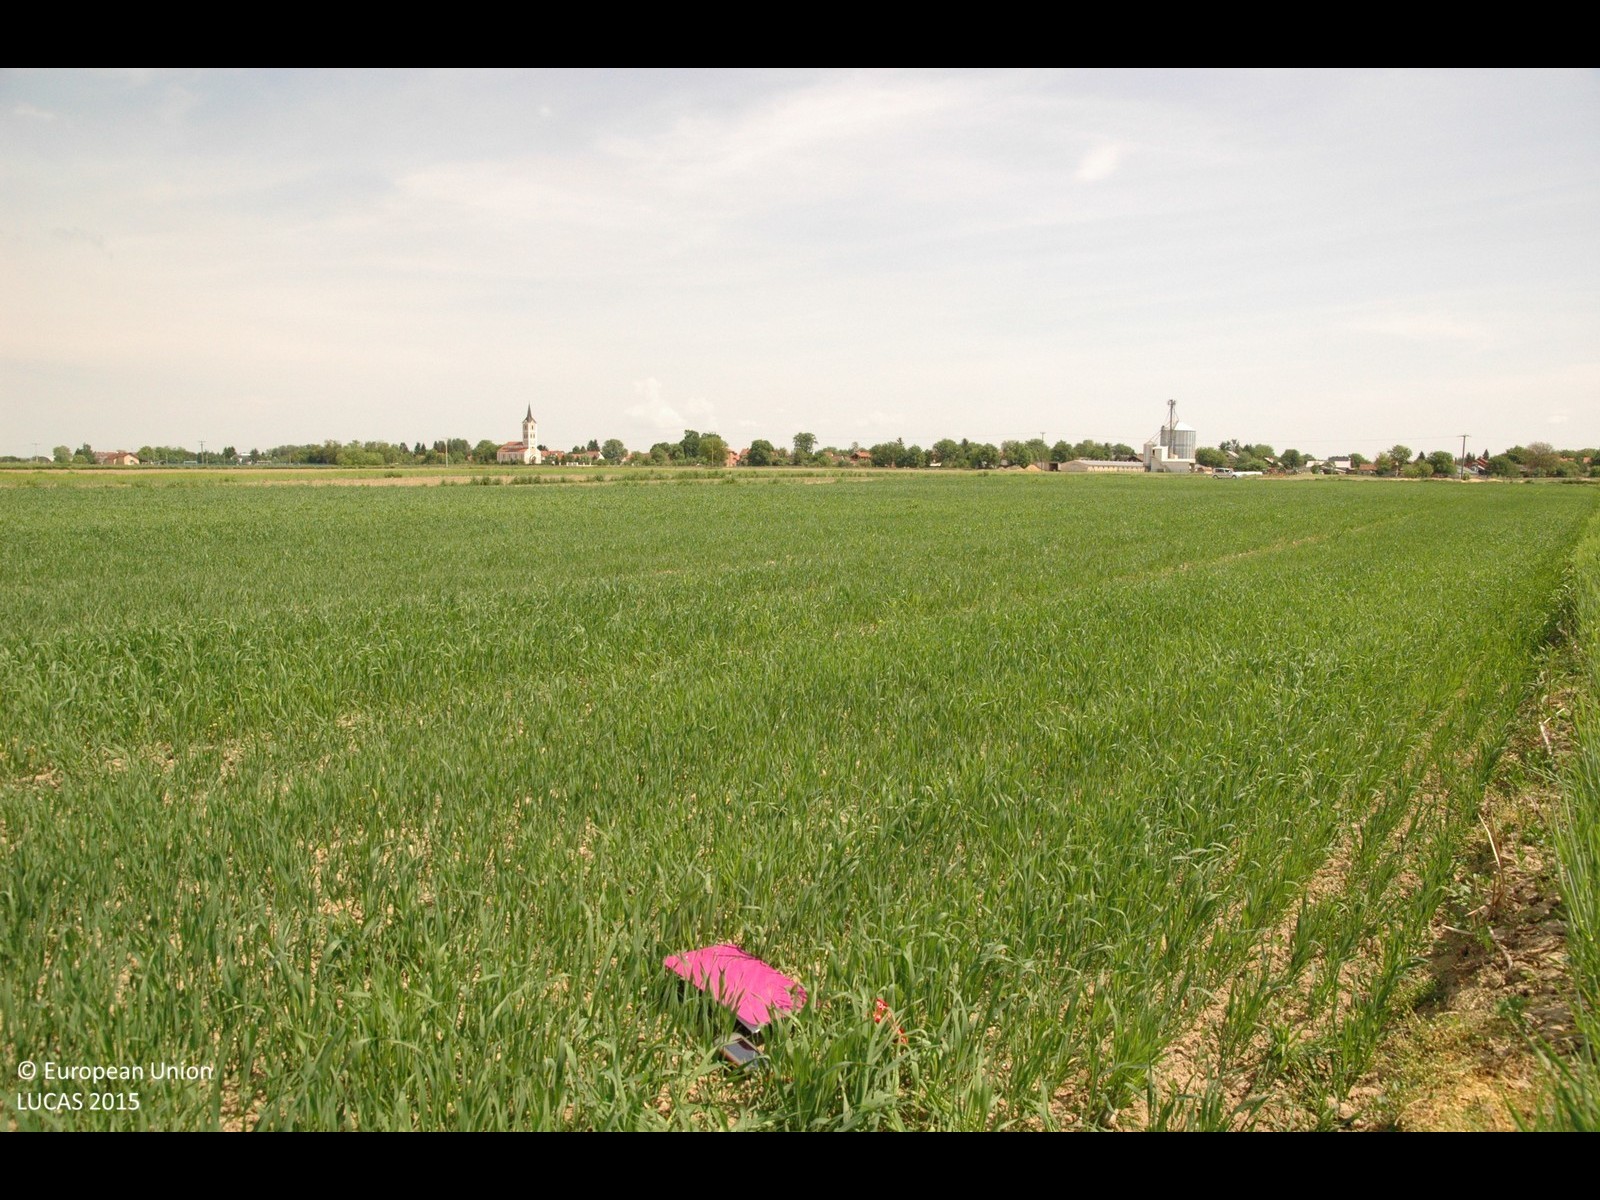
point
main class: Cropland
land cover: Common wheat
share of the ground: > 75 %
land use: Agriculture (excluding fallow land and kitchen gardens)
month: May
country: HR
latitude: 46.3429
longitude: 16.3538
